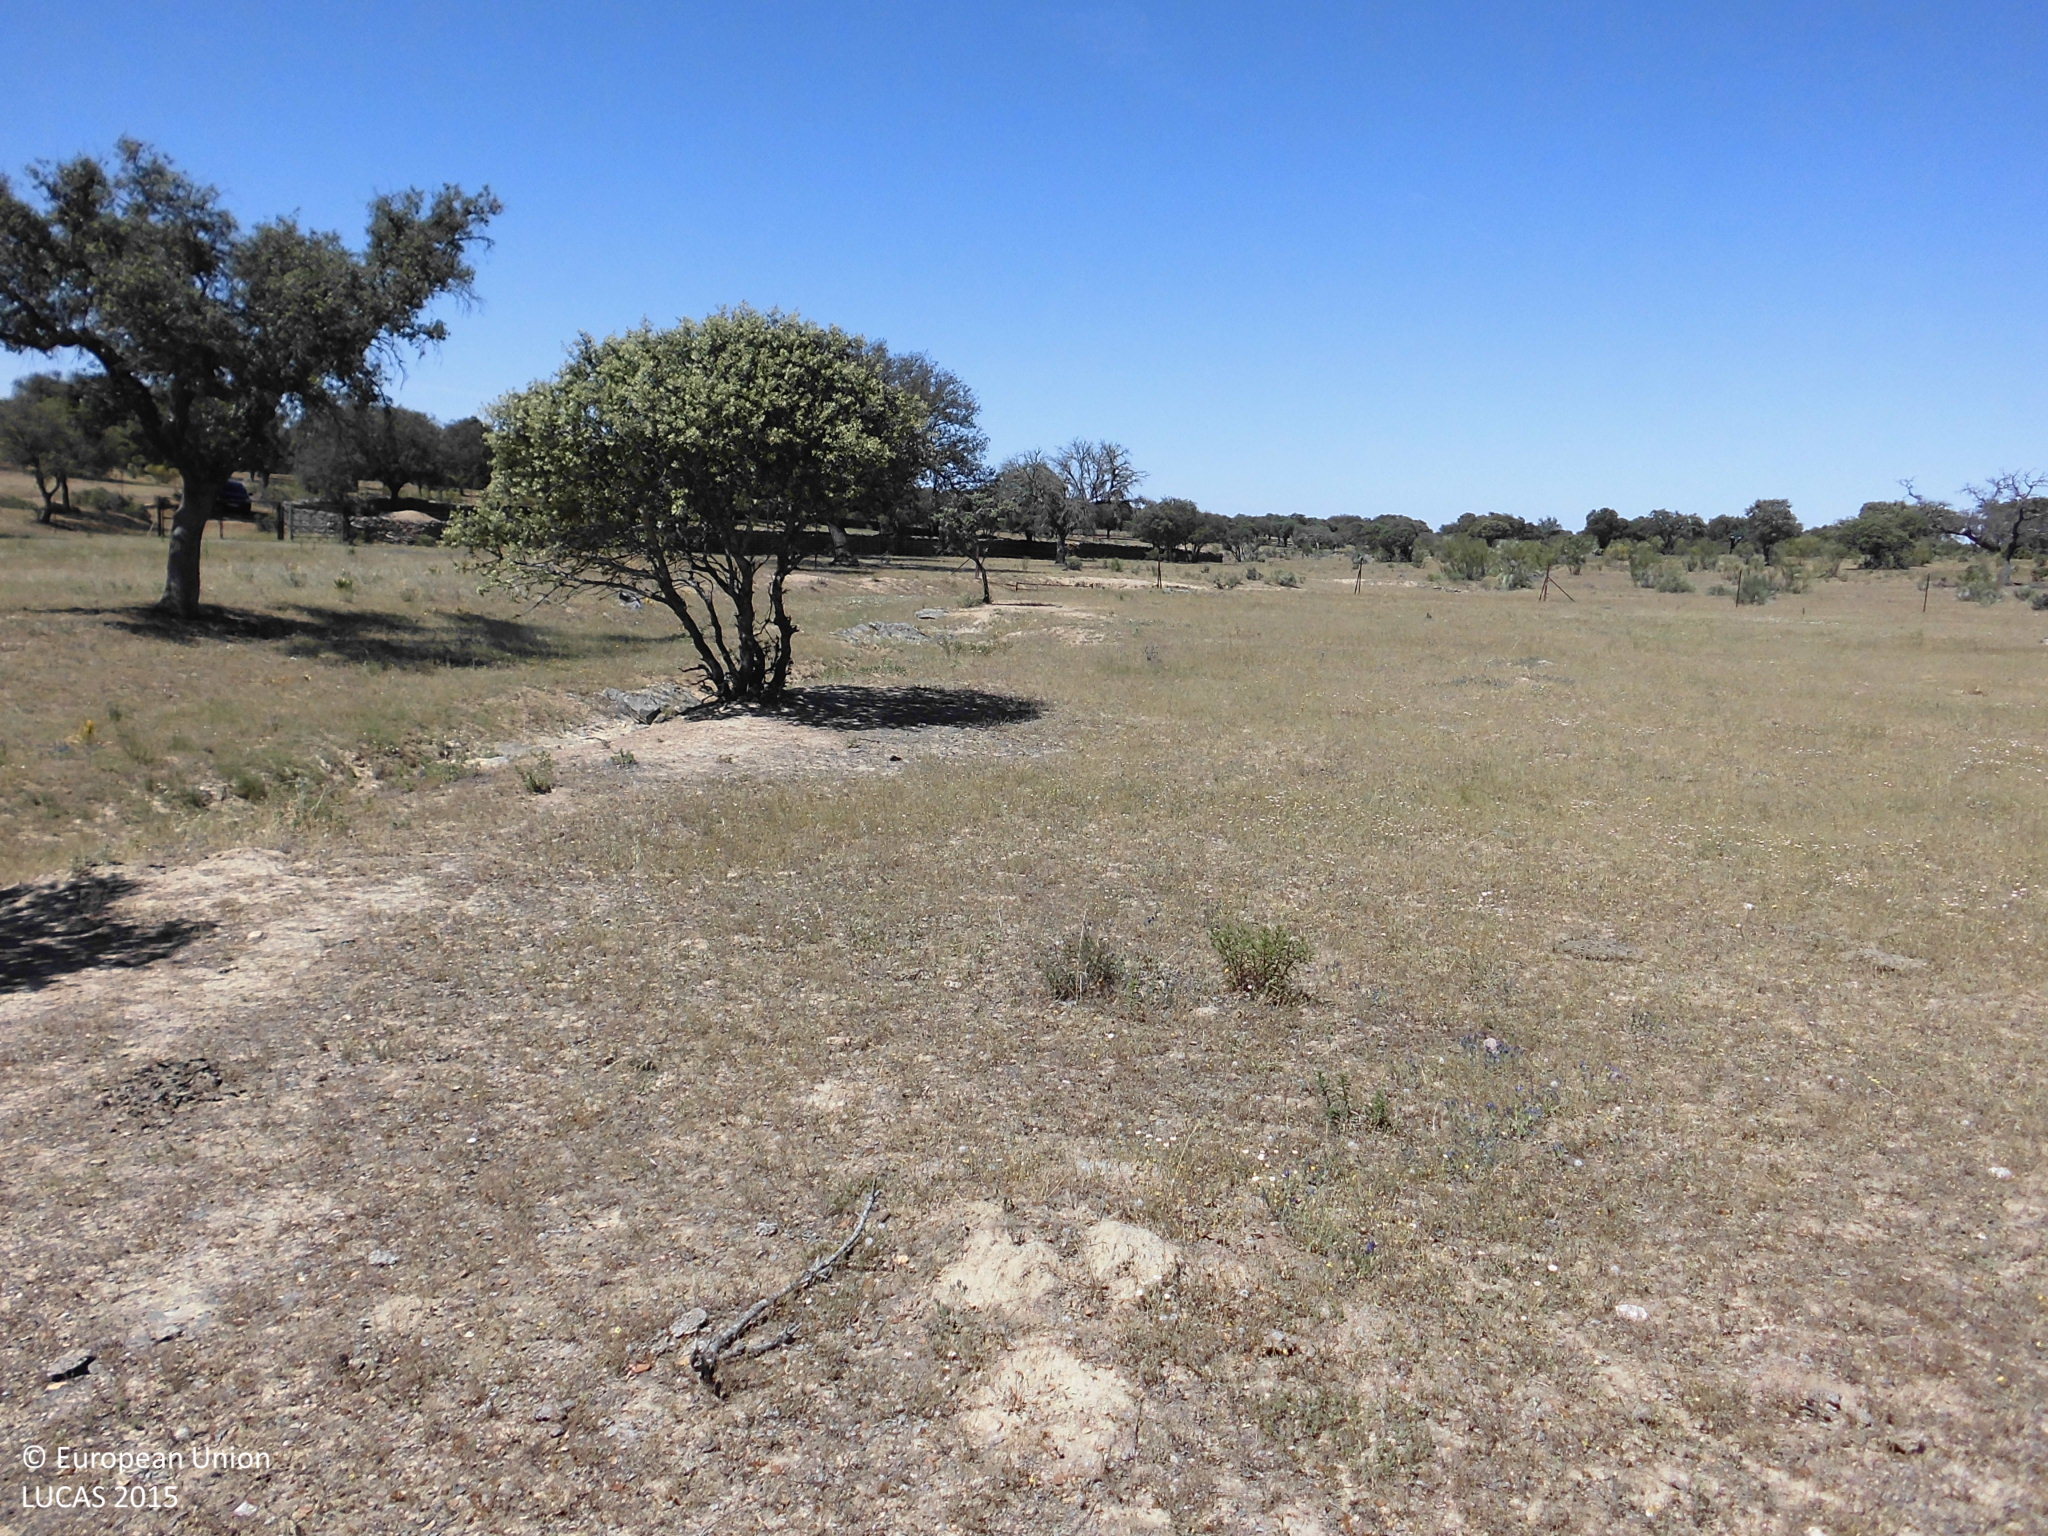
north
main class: Woodland
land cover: Broadleaved woodland
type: broadleaved evergreen forest
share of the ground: 10 - 25 %
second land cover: Grassland without tree/shrub cover
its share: > 75 %
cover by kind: herbaceous plants 80 %, broadleaved forest trees 20 %
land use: Forestry
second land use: Agriculture (excluding fallow land and kitchen gardens)
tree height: > 5 m
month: May
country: ES
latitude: 39.4500
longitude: -6.9173
